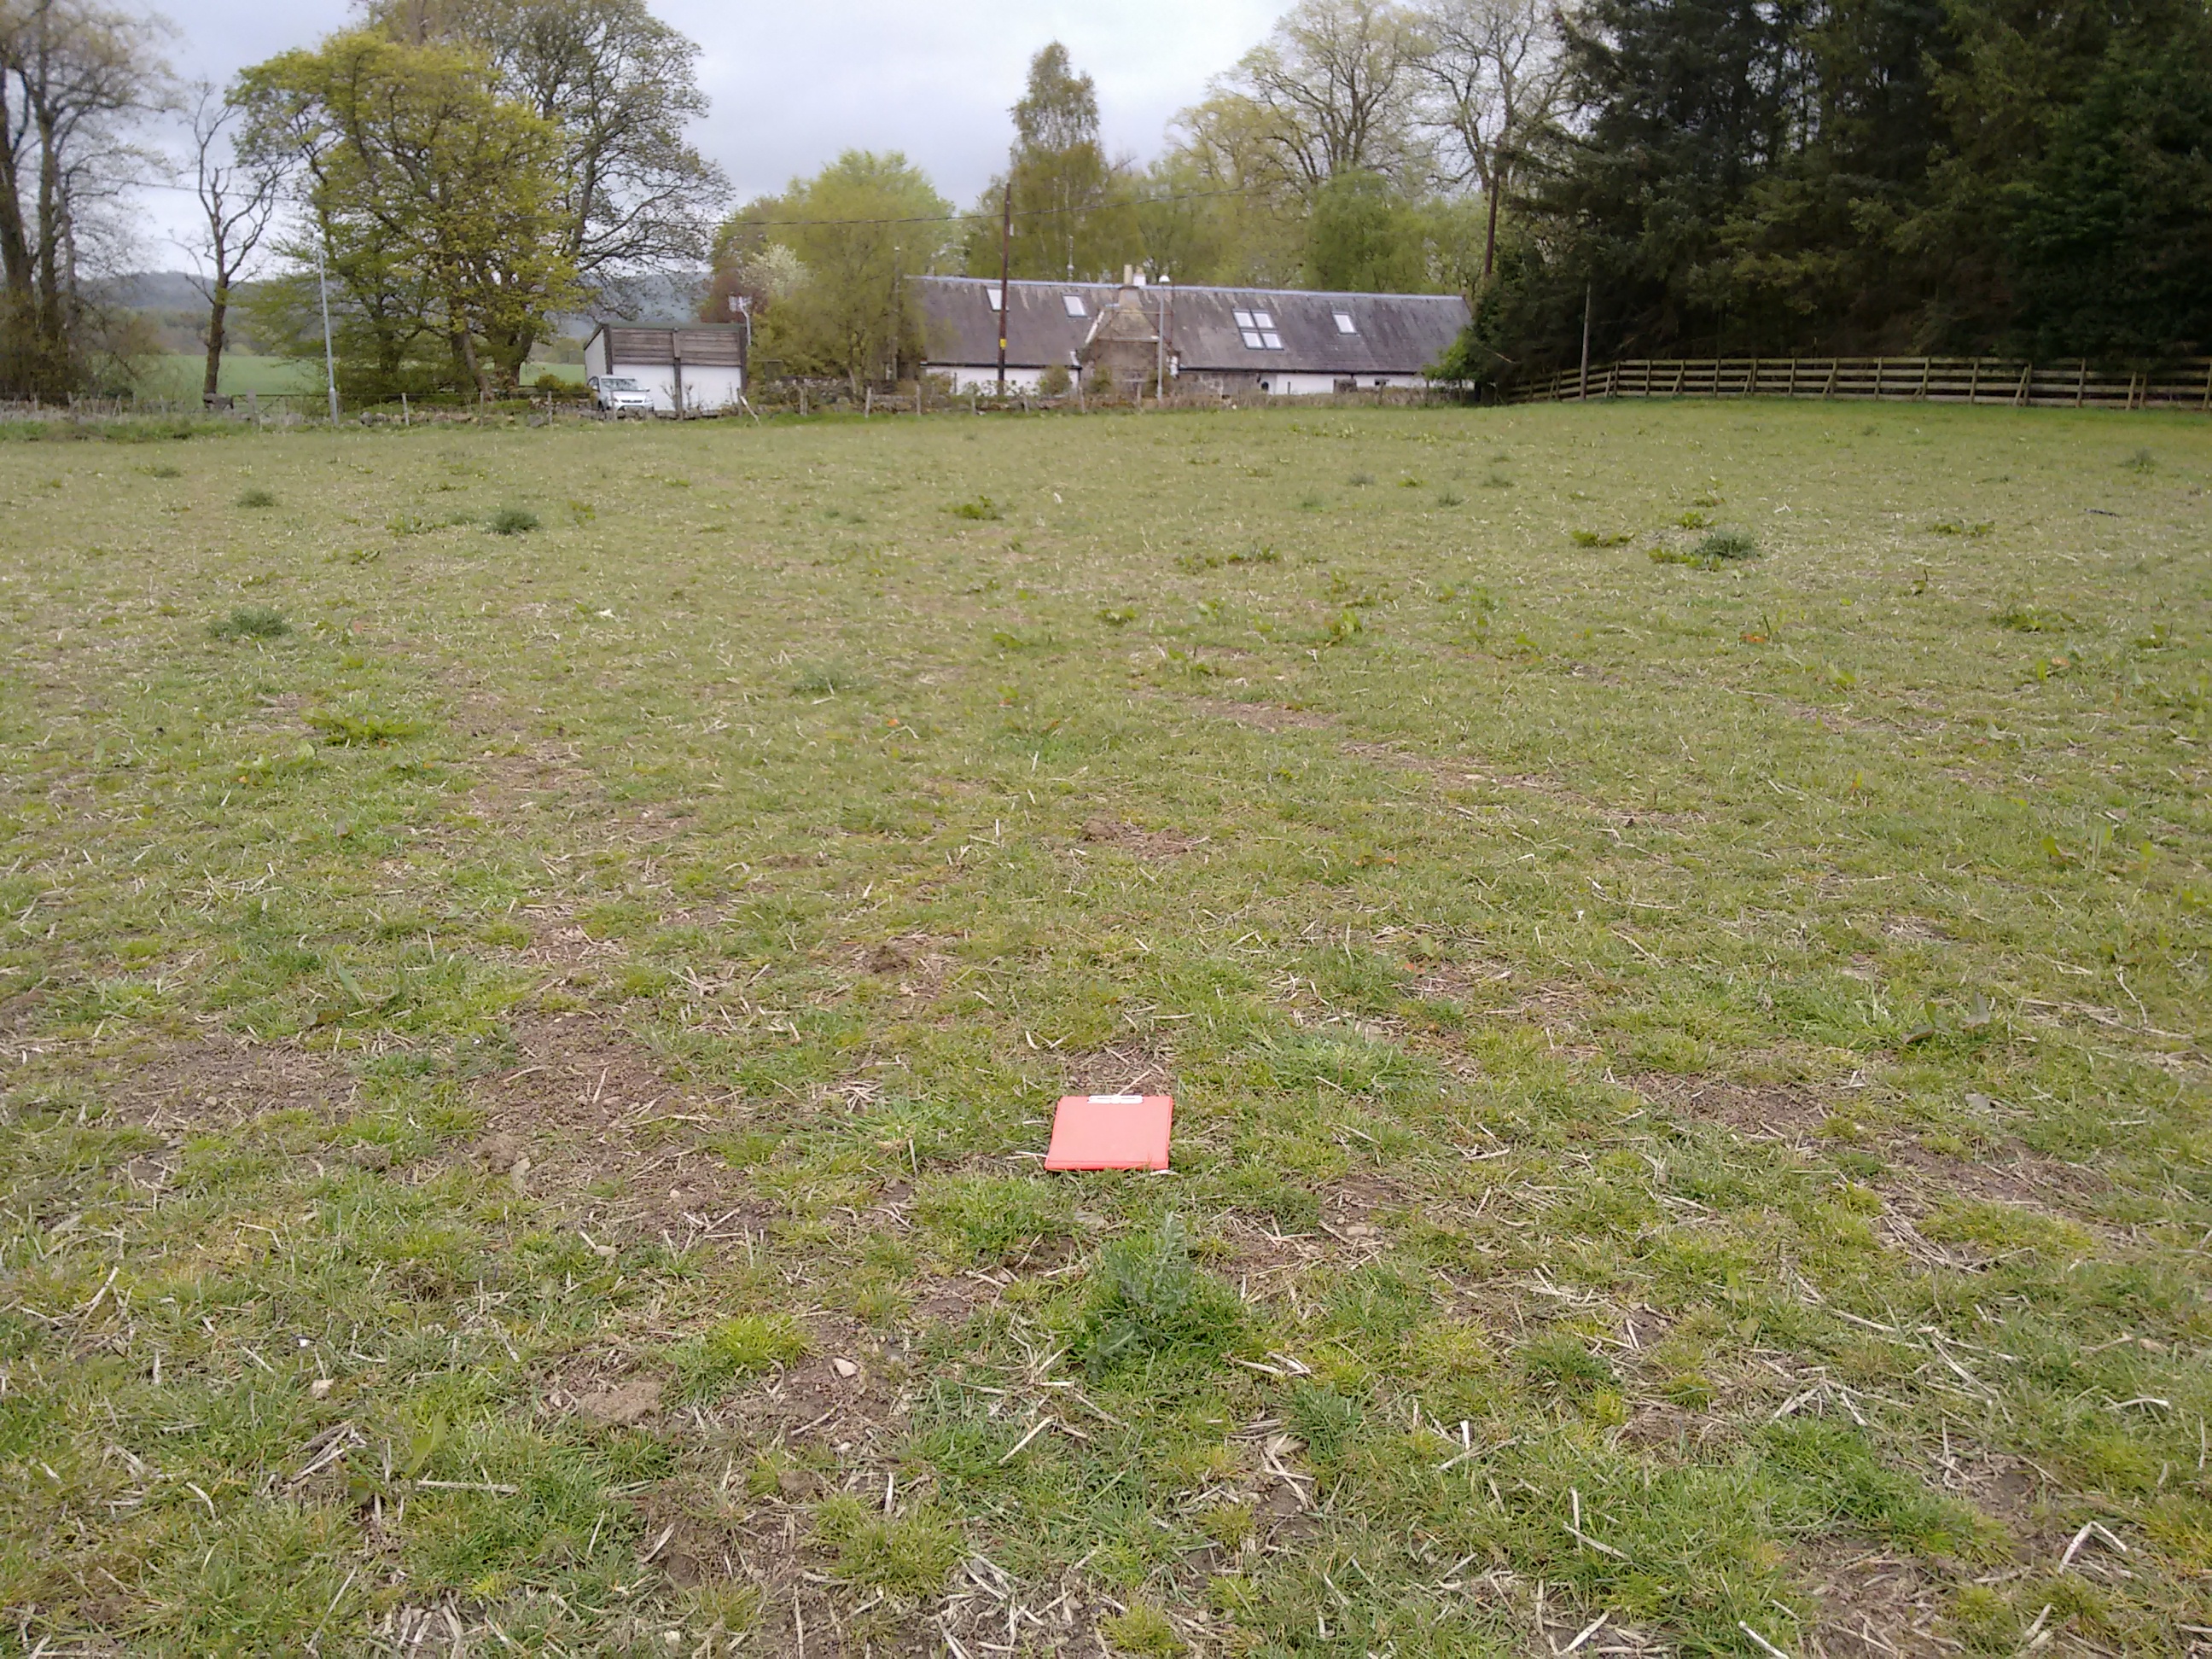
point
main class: Grassland
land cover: Grassland without tree/shrub cover
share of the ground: > 75 %
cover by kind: herbaceous plants 95 %, unconsolidated bare surface 5 %
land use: Agriculture (excluding fallow land and kitchen gardens)
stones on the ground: < 10 %
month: May
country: GB
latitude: 55.9232
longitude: -3.6999
